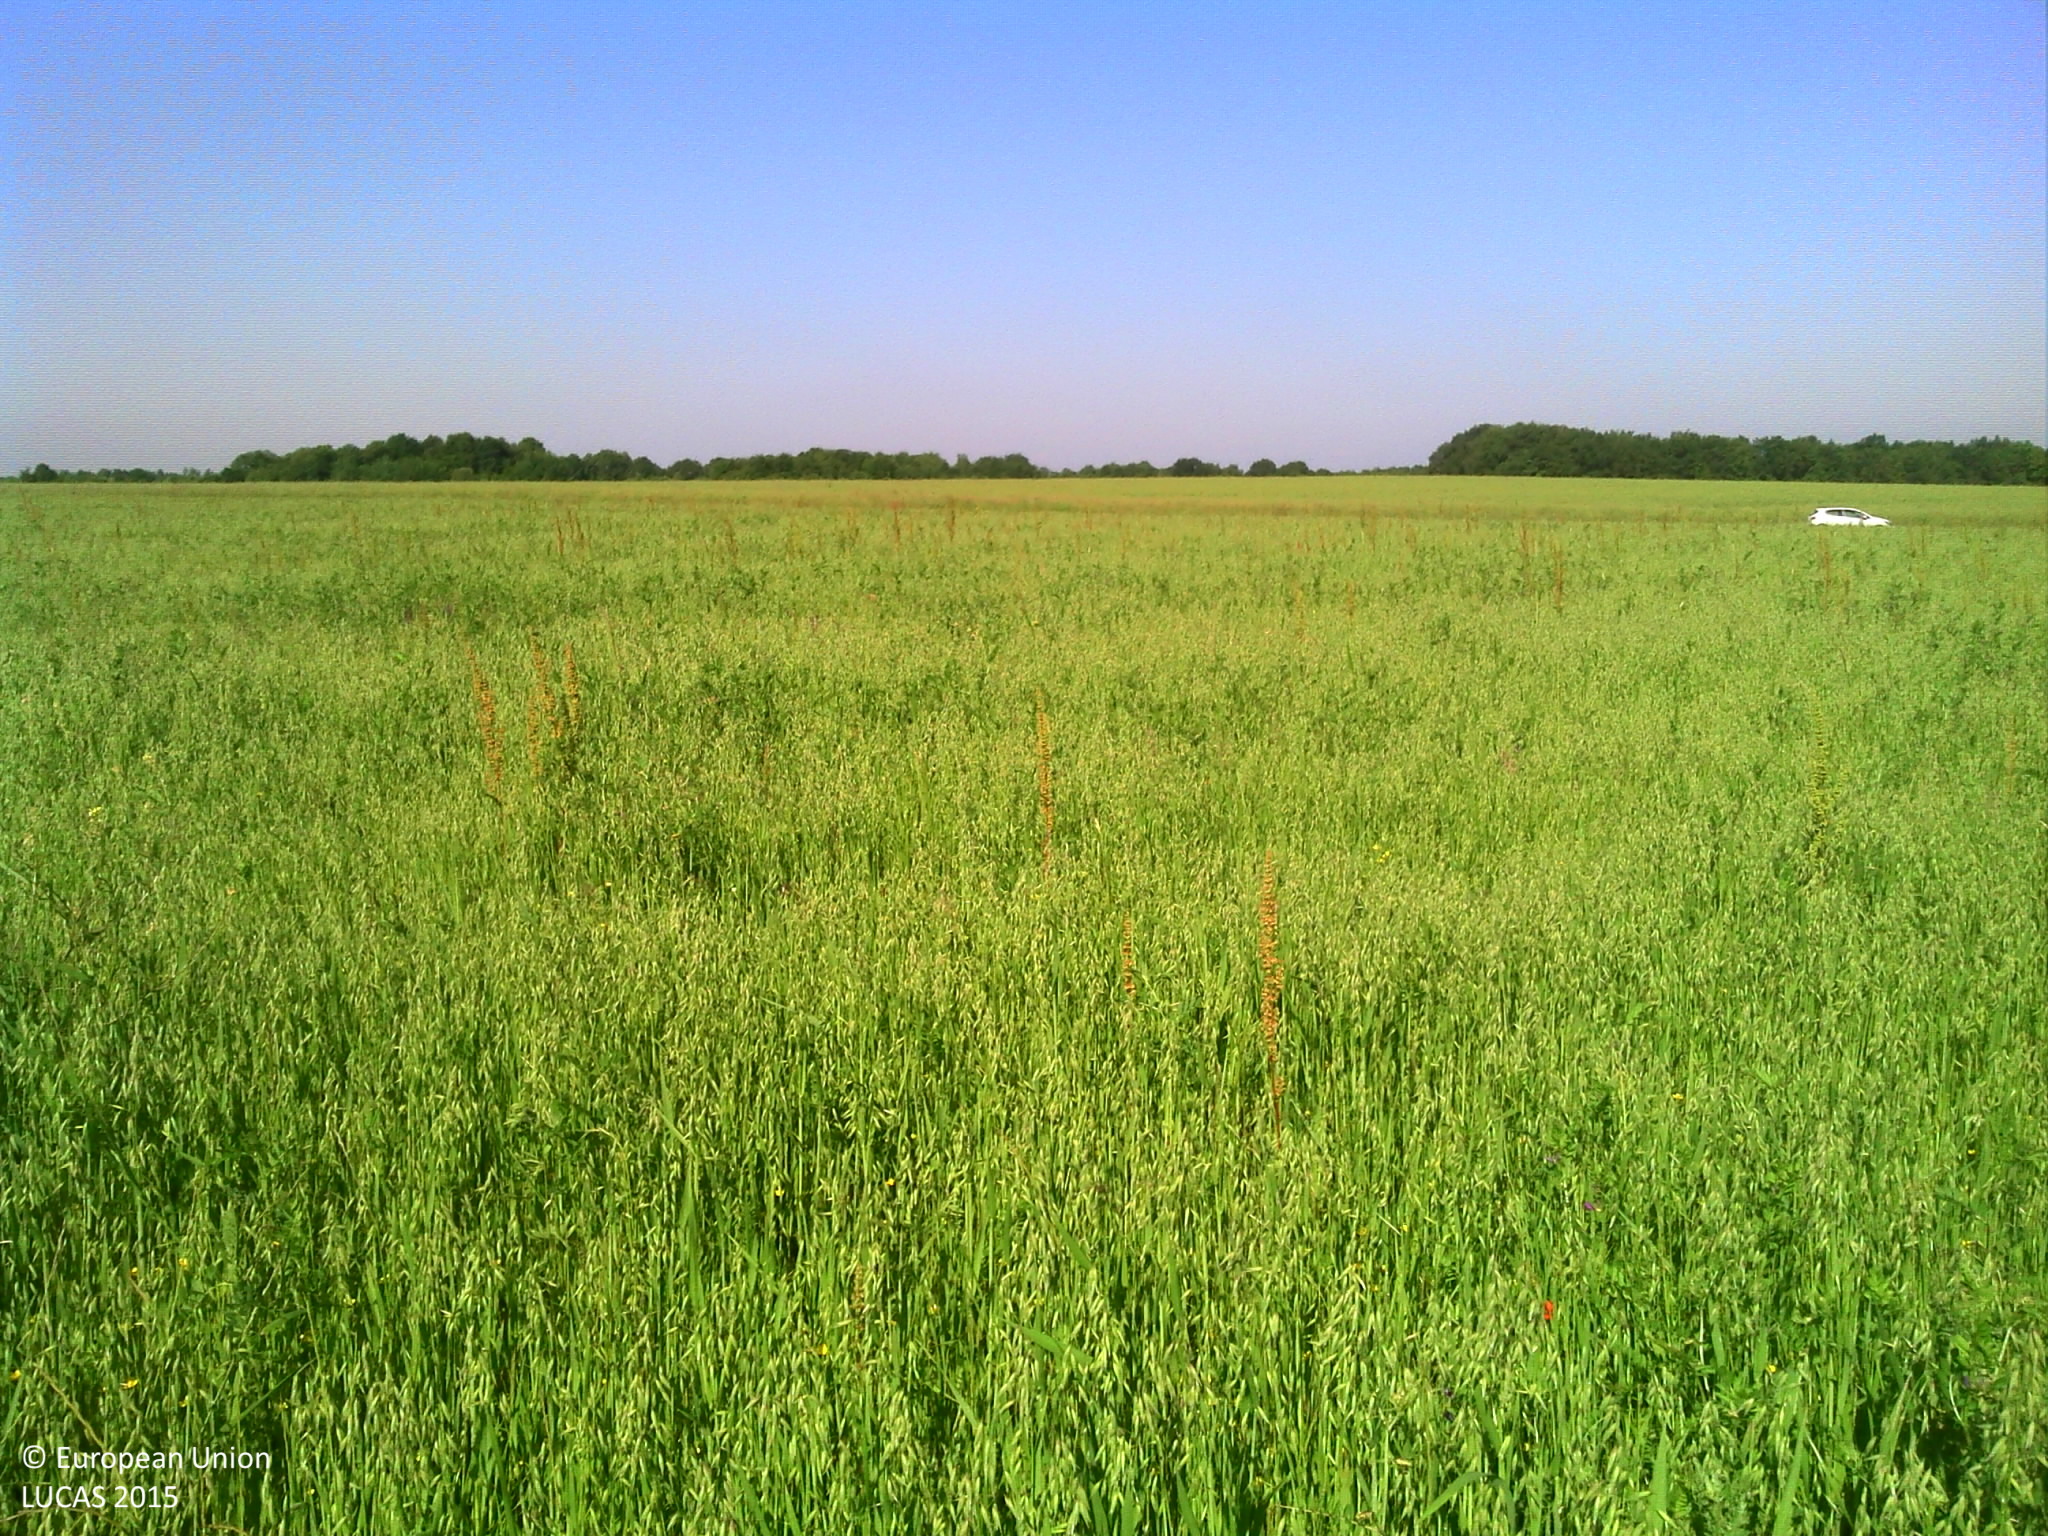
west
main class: Cropland
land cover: Mixed cereals for fodder
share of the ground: > 75 %
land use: Agriculture (excluding fallow land and kitchen gardens)
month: May
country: FR
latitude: 47.4567
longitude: 1.0028
